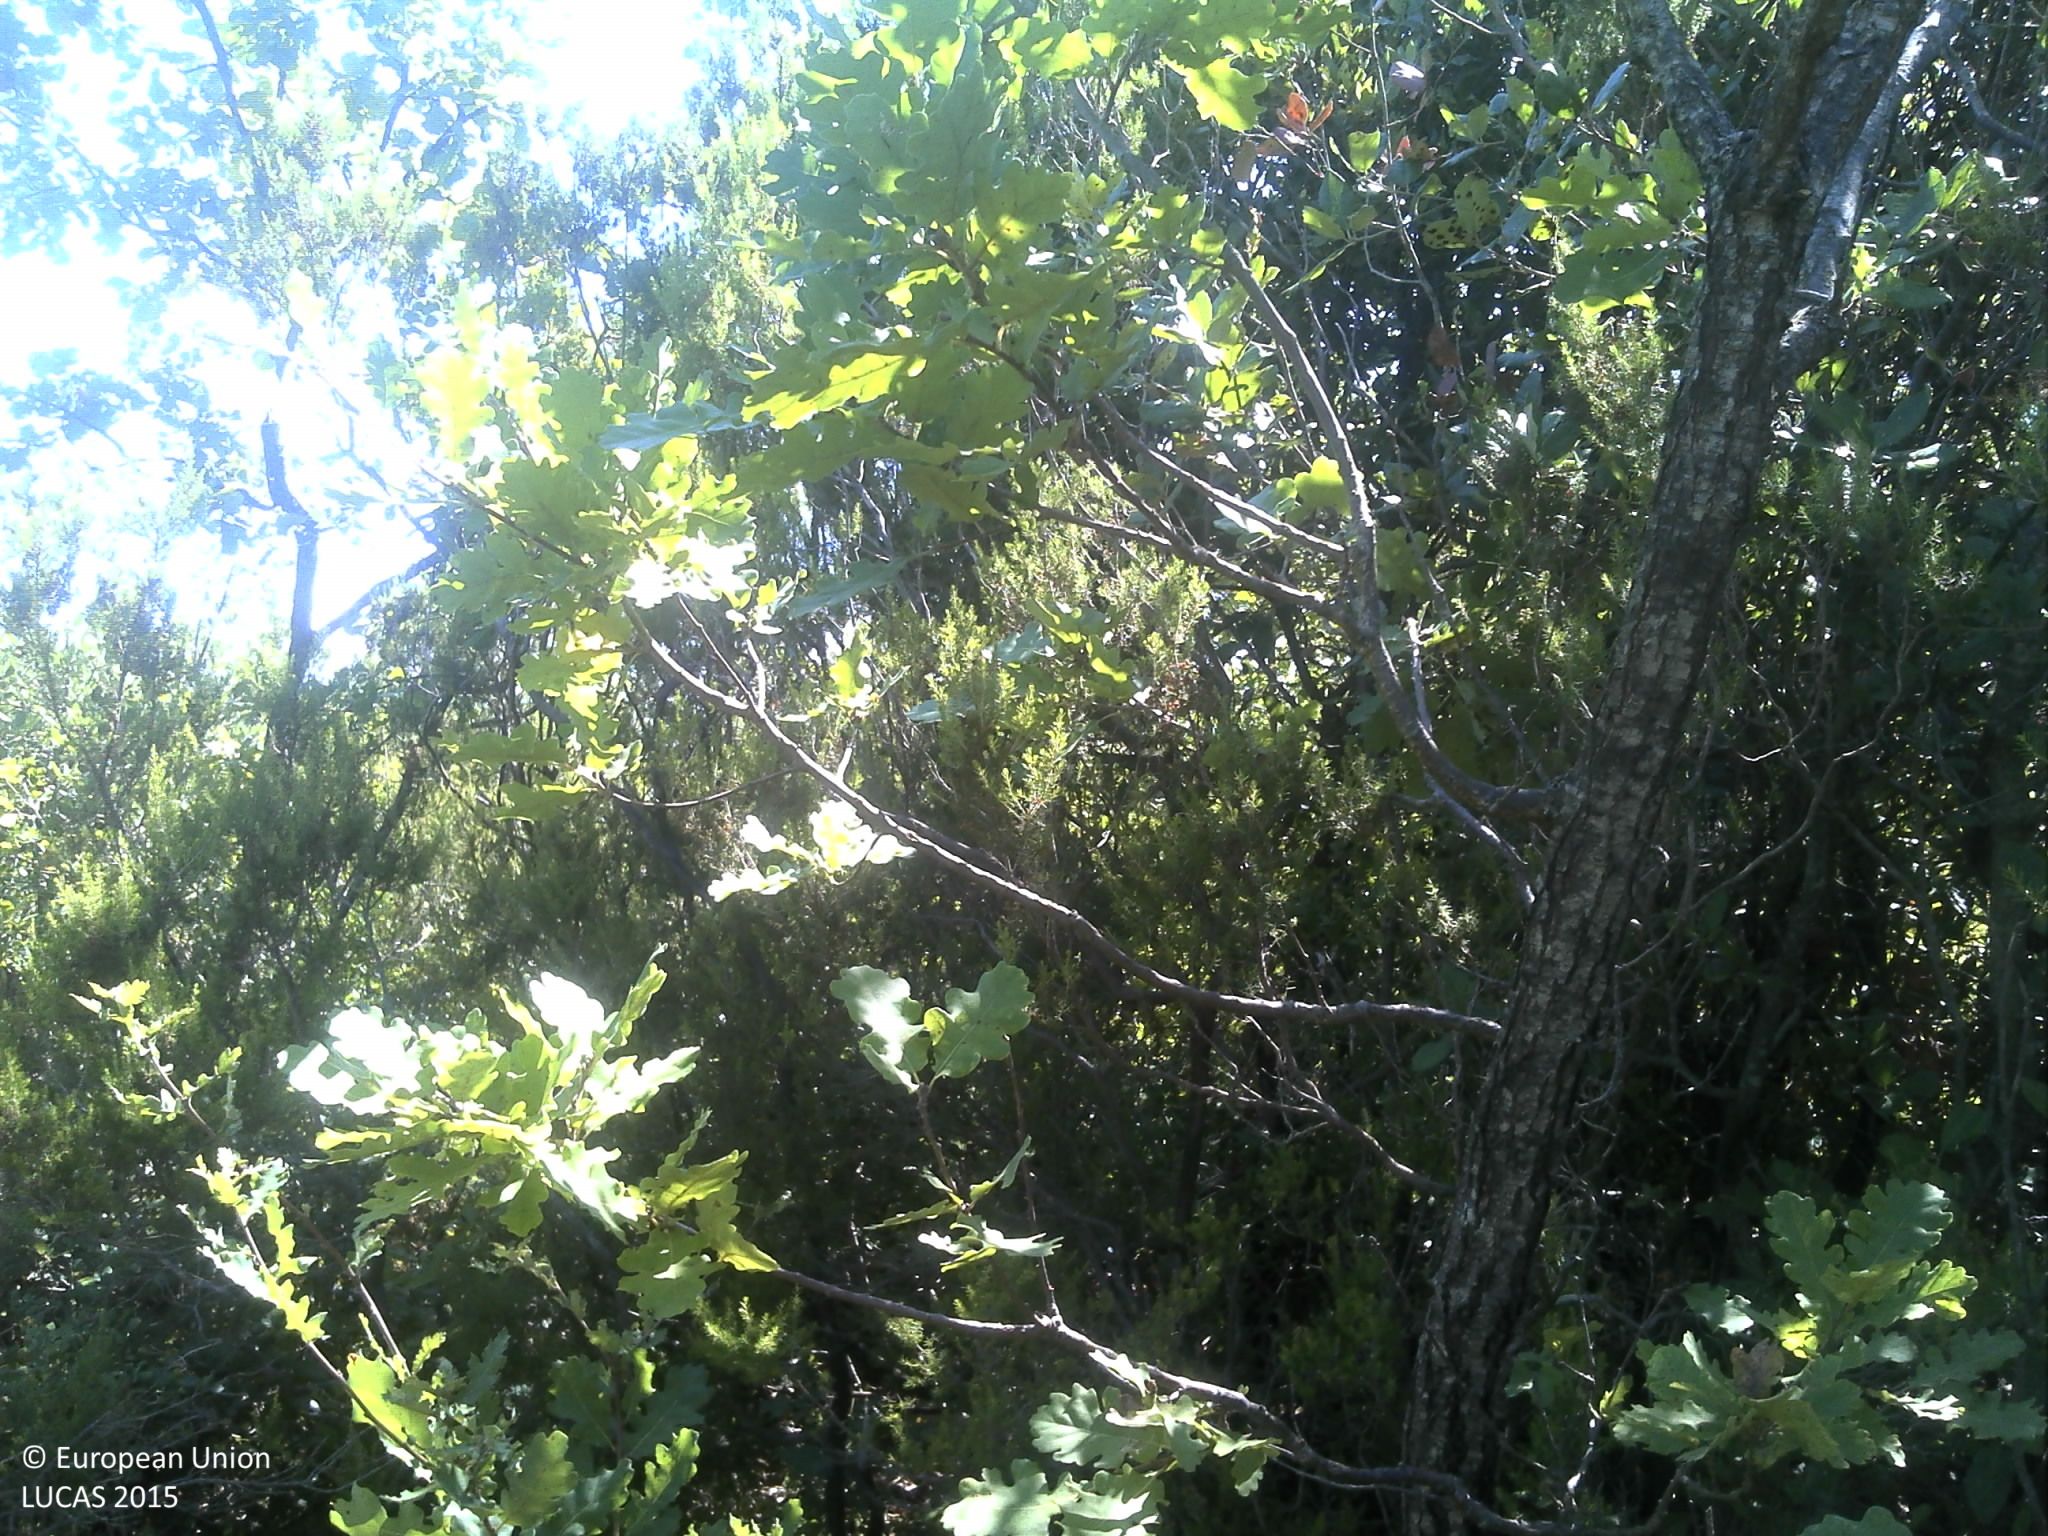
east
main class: Woodland
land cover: Broadleaved woodland
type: thermophilous deciduous forest
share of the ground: > 75 %
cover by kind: shrubs 65 %, broadleaved forest trees 20 %, unconsolidated bare surface 10 %, coniferous forest trees 5 %
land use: Semi-natural and natural areas not in use
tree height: > 5 m
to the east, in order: Broadleaved woodland; Pine dominated mixed woodland; Pine dominated coniferous woodland; Tracks; Shrubland with sparse tree cover
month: August
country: HR
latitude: 43.9164
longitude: 15.4834
